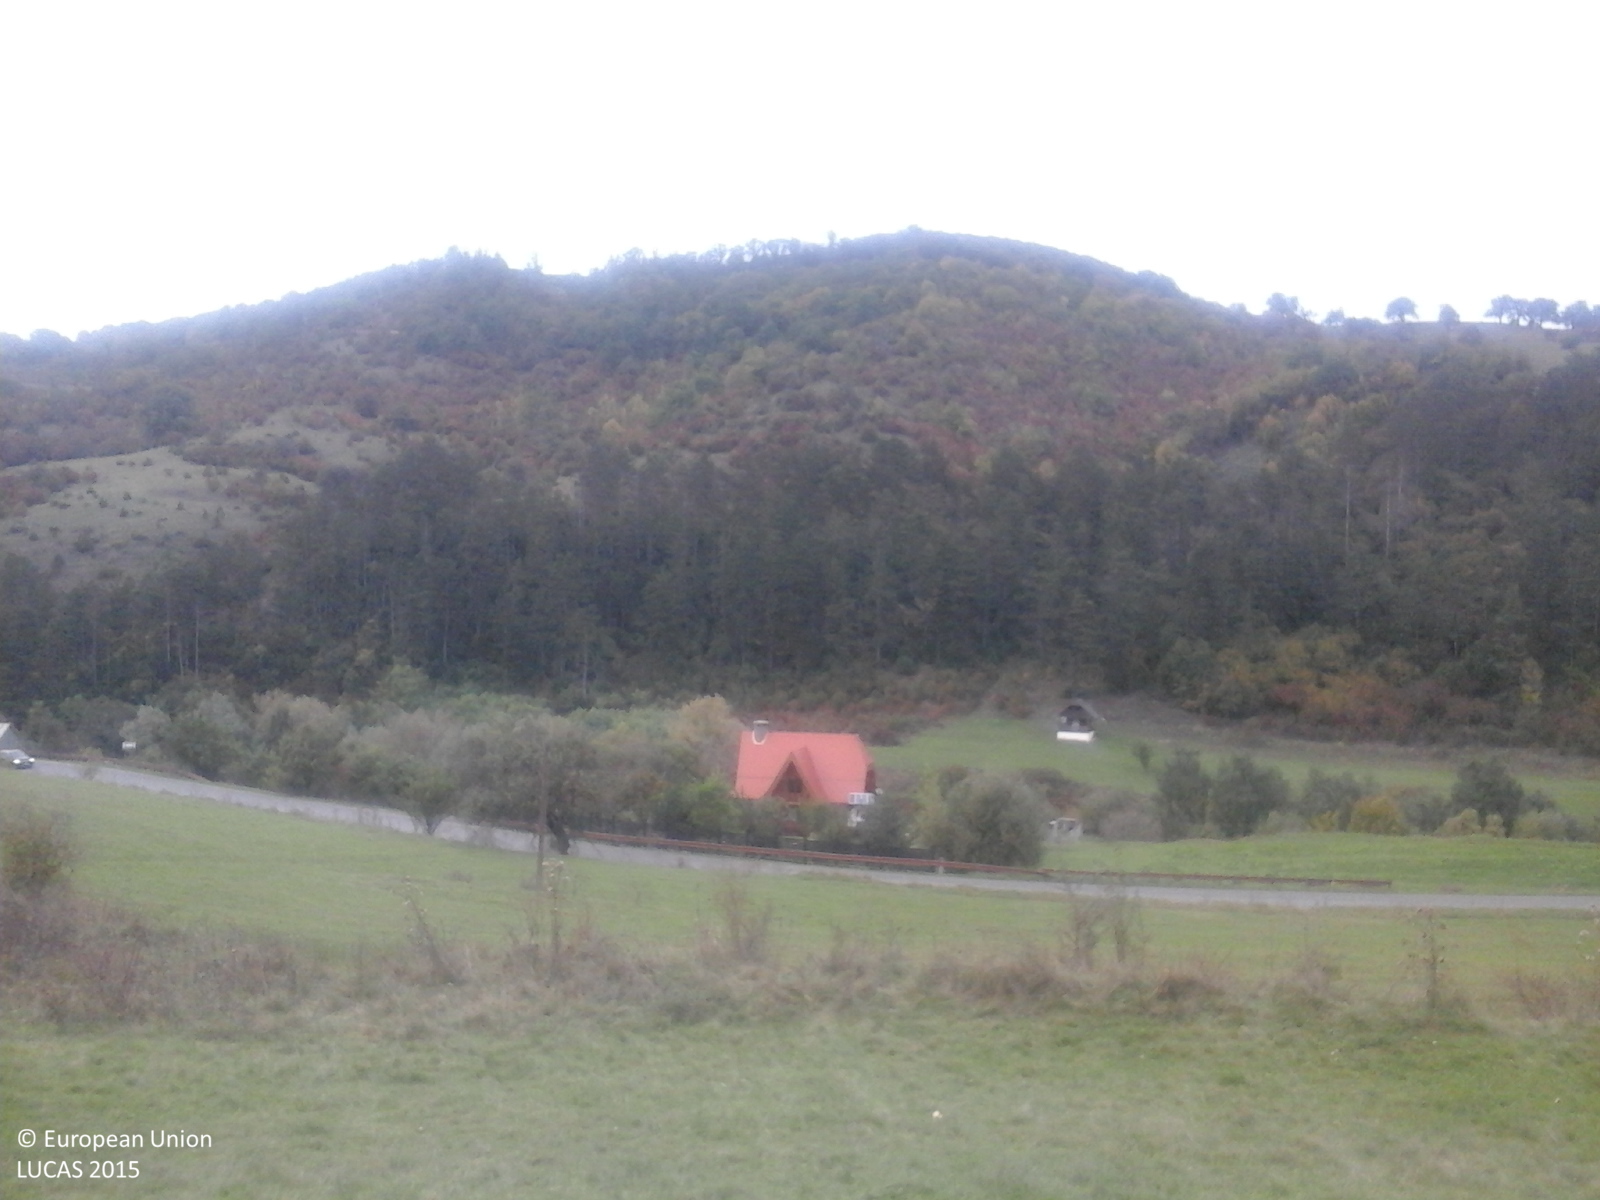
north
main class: Grassland
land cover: Grassland without tree/shrub cover
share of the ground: > 75 %
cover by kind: herbaceous plants 100 %
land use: Agriculture (excluding fallow land and kitchen gardens)
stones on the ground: < 10 %
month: October
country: RO
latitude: 46.2687
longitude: 25.2965
